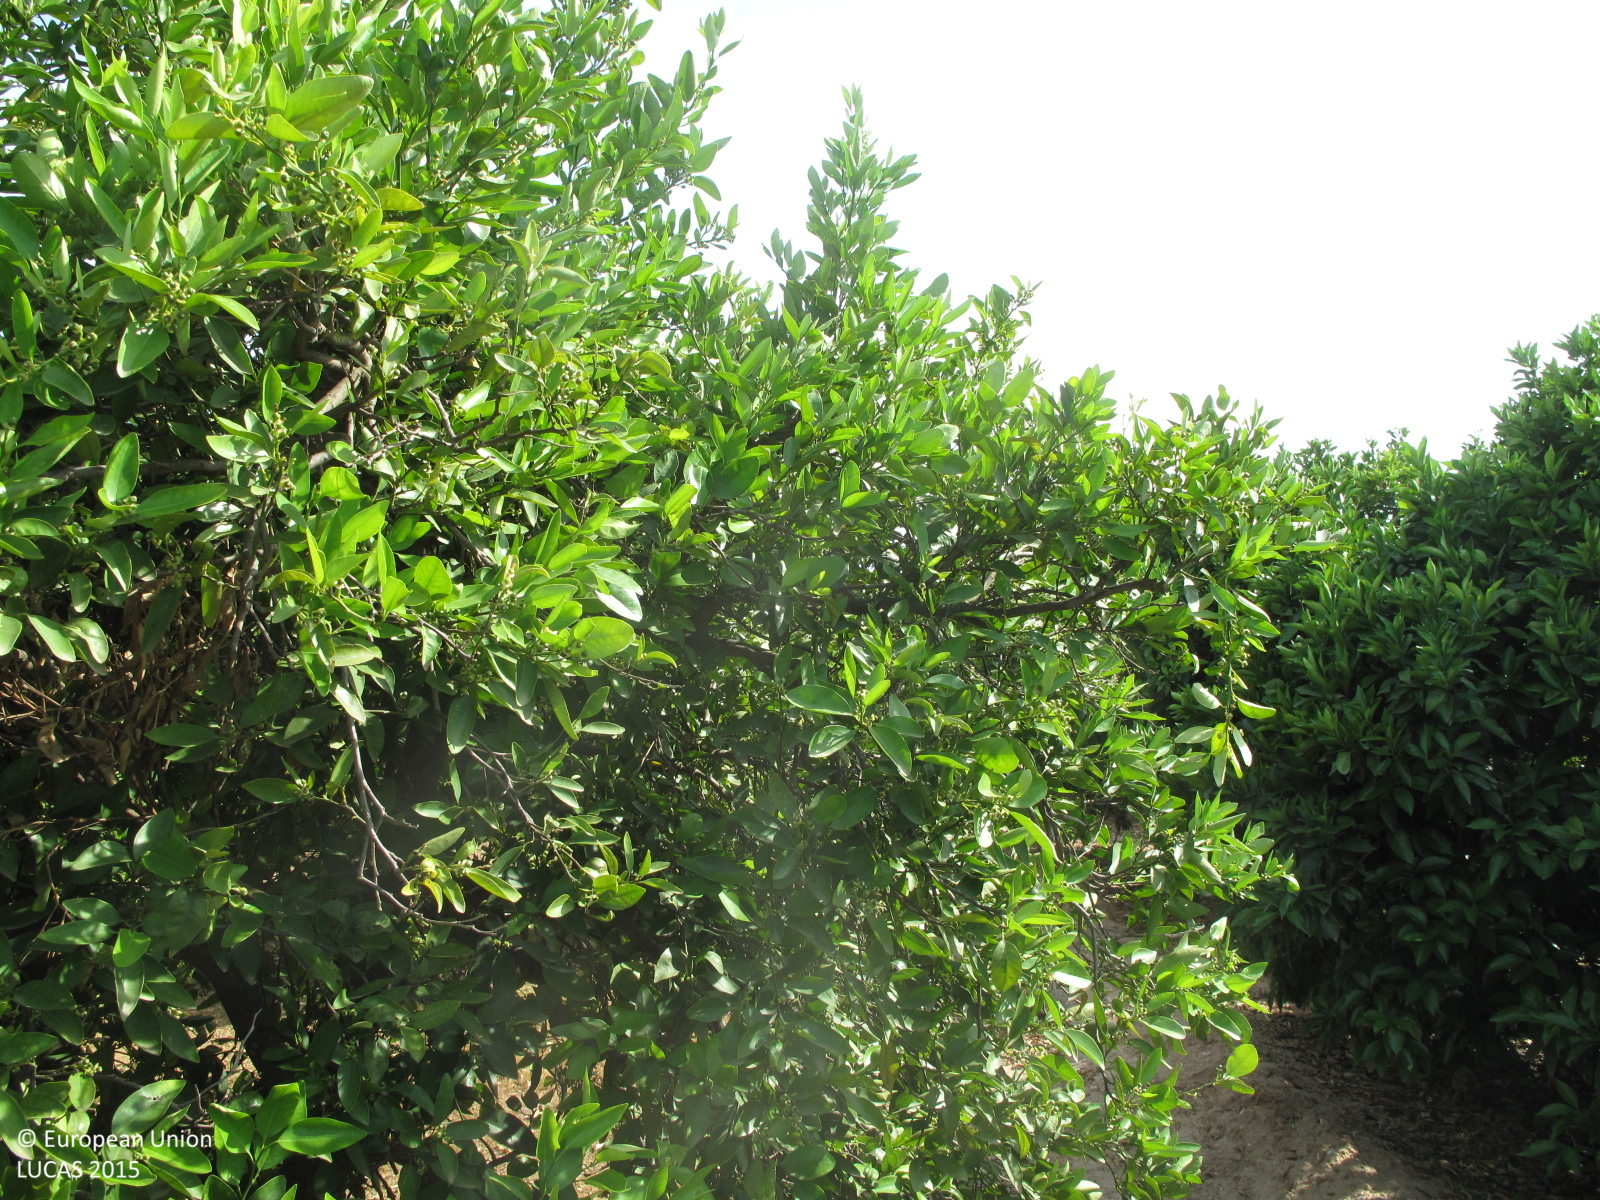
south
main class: Cropland
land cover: Oranges
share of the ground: > 75 %
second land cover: Other bare soil
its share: > 75 %
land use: Agriculture (excluding fallow land and kitchen gardens)
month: May
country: ES
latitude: 39.0720
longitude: -0.5930
